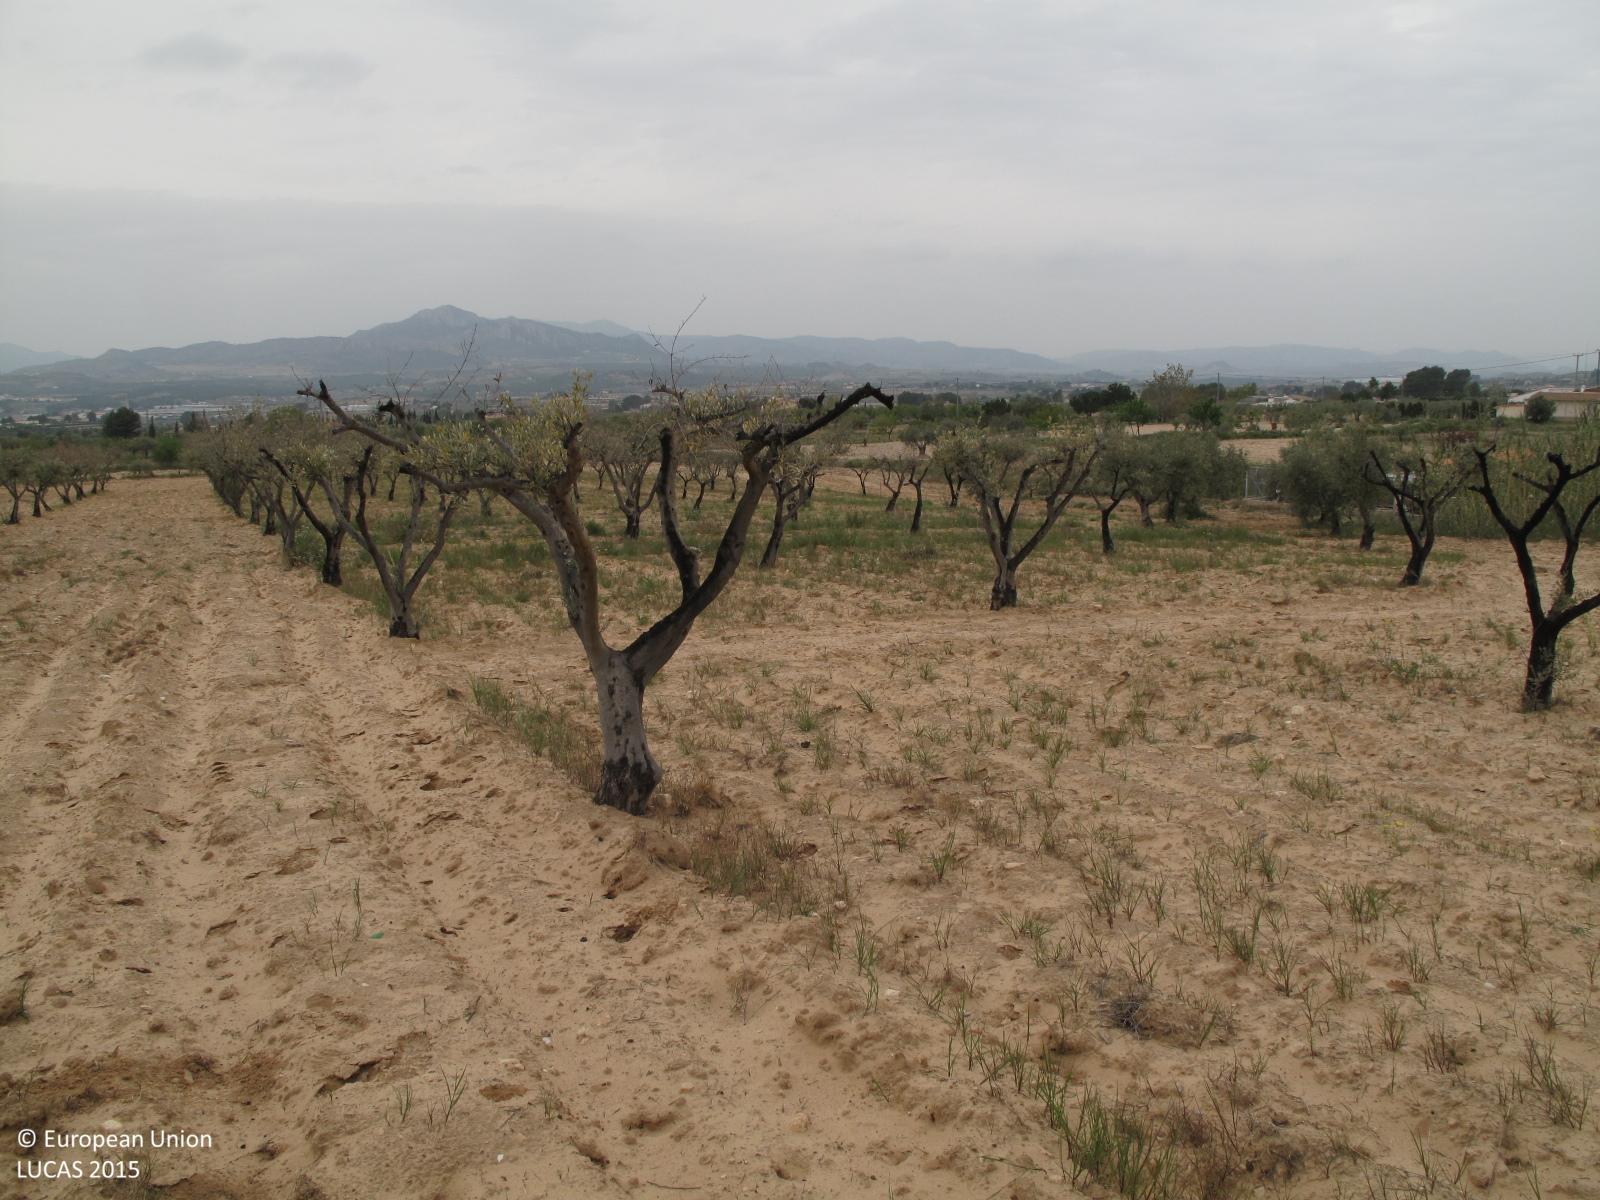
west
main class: Cropland
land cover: Olive groves
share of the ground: < 10 %
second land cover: Other bare soil
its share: > 75 %
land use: Agriculture (excluding fallow land and kitchen gardens)
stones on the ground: 10 - 25 %
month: April
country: ES
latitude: 38.5574
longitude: -0.7875
